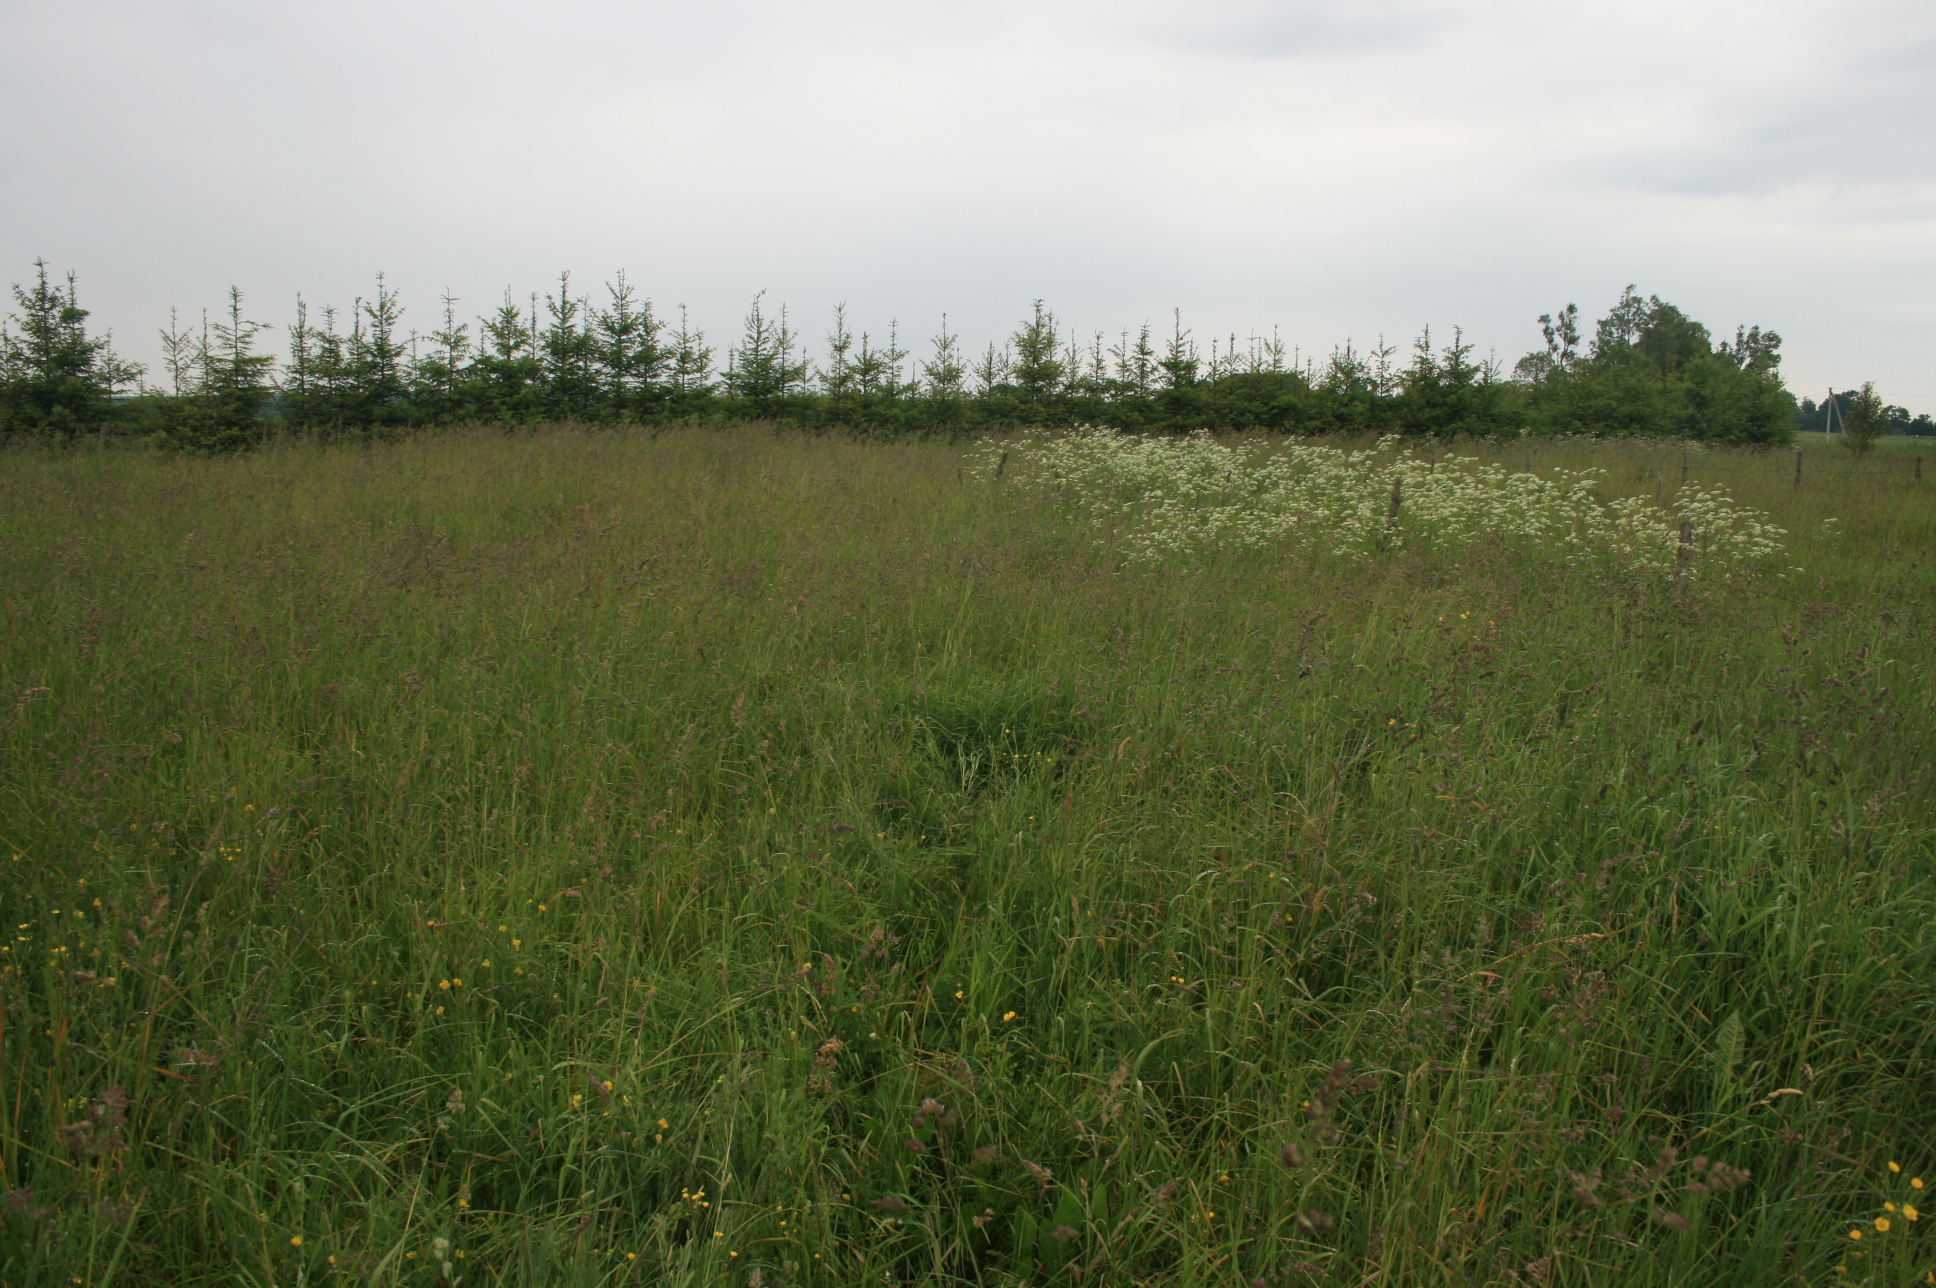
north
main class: Grassland
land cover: Grassland without tree/shrub cover
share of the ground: > 75 %
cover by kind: herbaceous plants 100 %
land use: Agriculture (excluding fallow land and kitchen gardens)
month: June
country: LT
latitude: 55.4819
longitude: 22.3213
